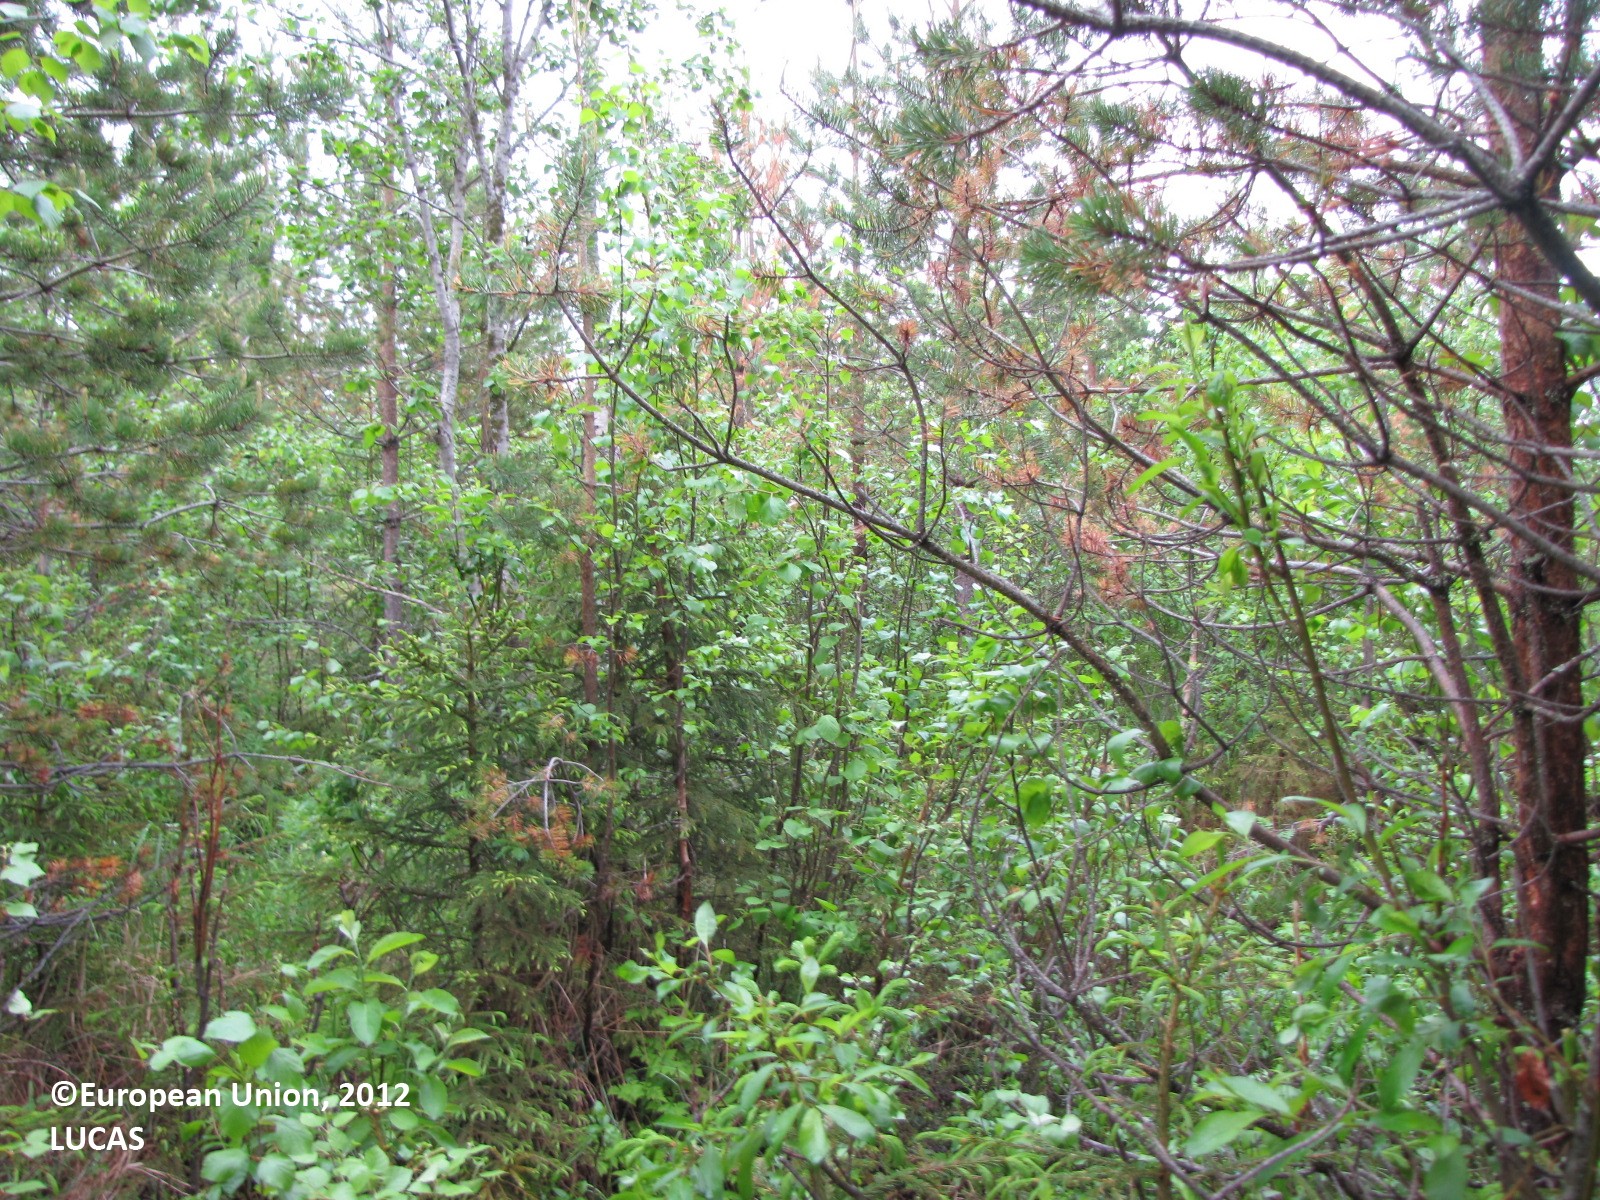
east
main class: Woodland
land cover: Other mixed woodland
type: boreal forest
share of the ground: > 75 %
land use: Forestry
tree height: > 5 m
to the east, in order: Other mixed woodland; Ditches and canals; Other mixed woodland; Ditches and canals; Other mixed woodland; Ditches and canals; Other mixed woodland; Ditches and canals; Other mixed woodland
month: June
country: FI
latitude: 66.0020
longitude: 24.4389
